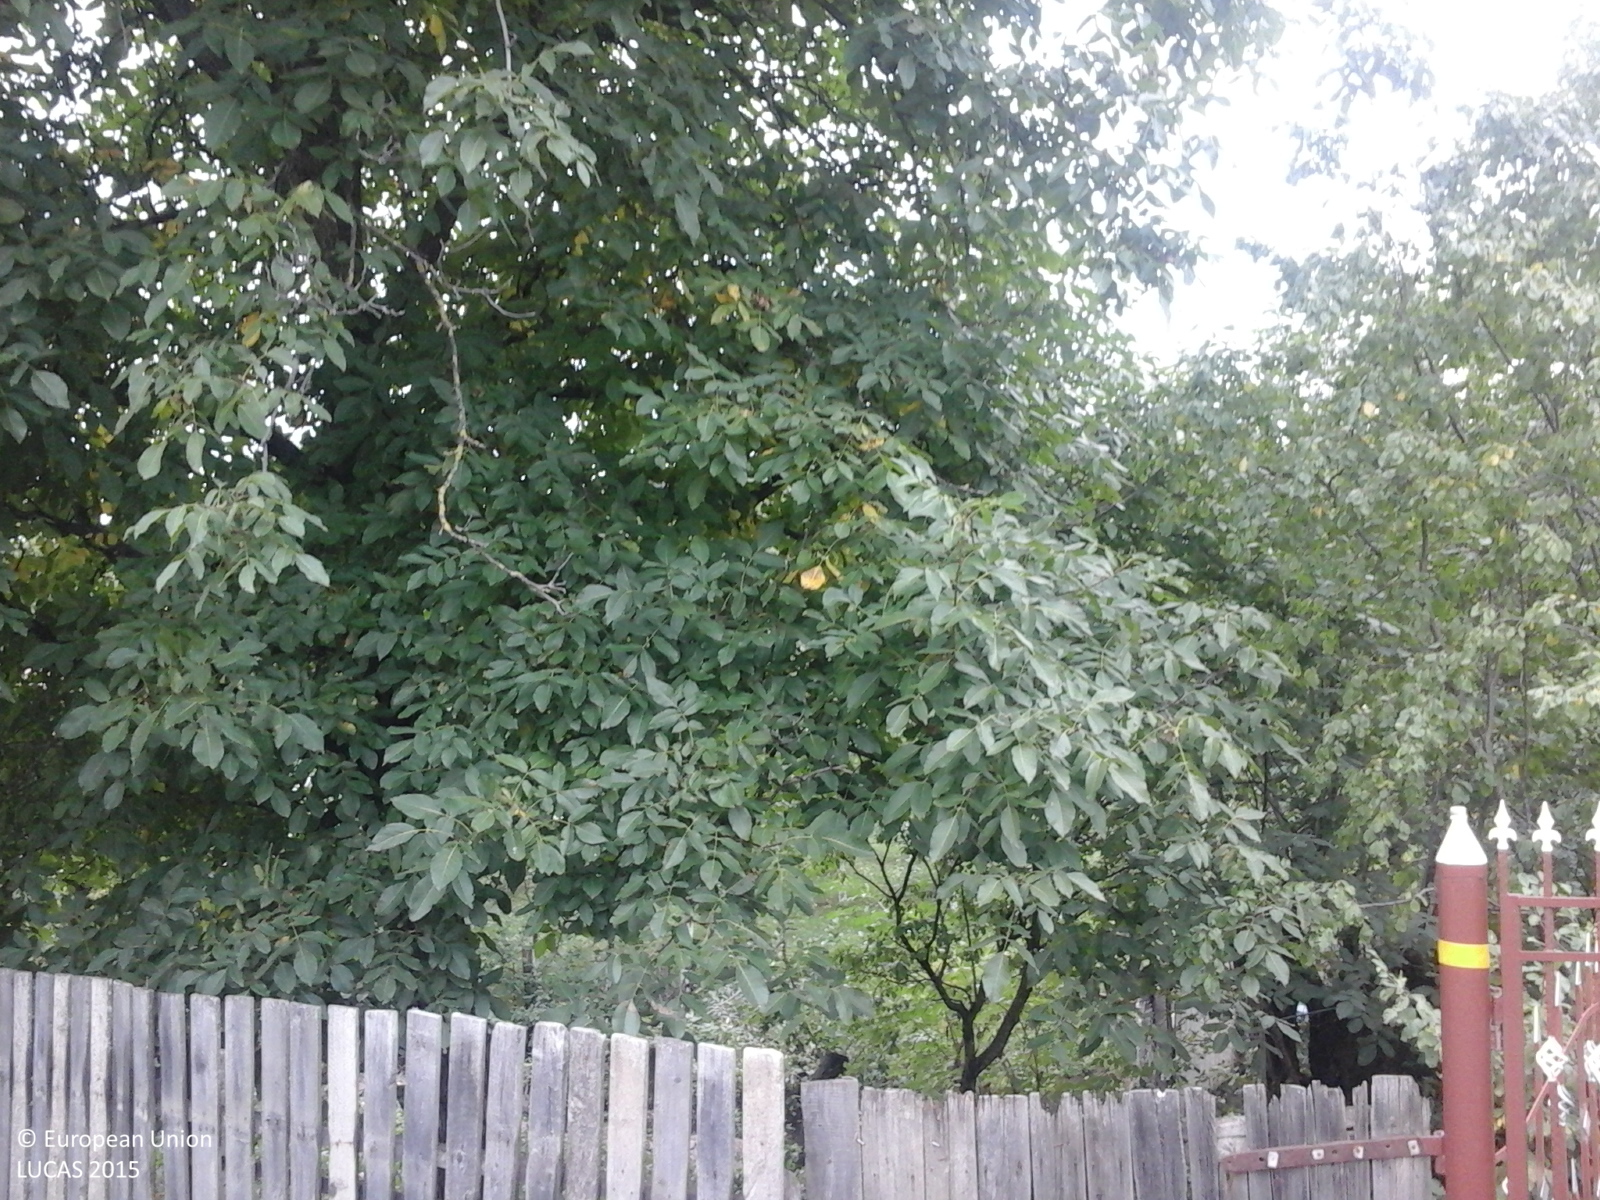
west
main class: Cropland
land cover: Apple fruit
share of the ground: > 75 %
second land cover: Grassland without tree/shrub cover
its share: > 75 %
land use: Agriculture (excluding fallow land and kitchen gardens)
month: October
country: RO
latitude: 46.8092
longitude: 24.9728
